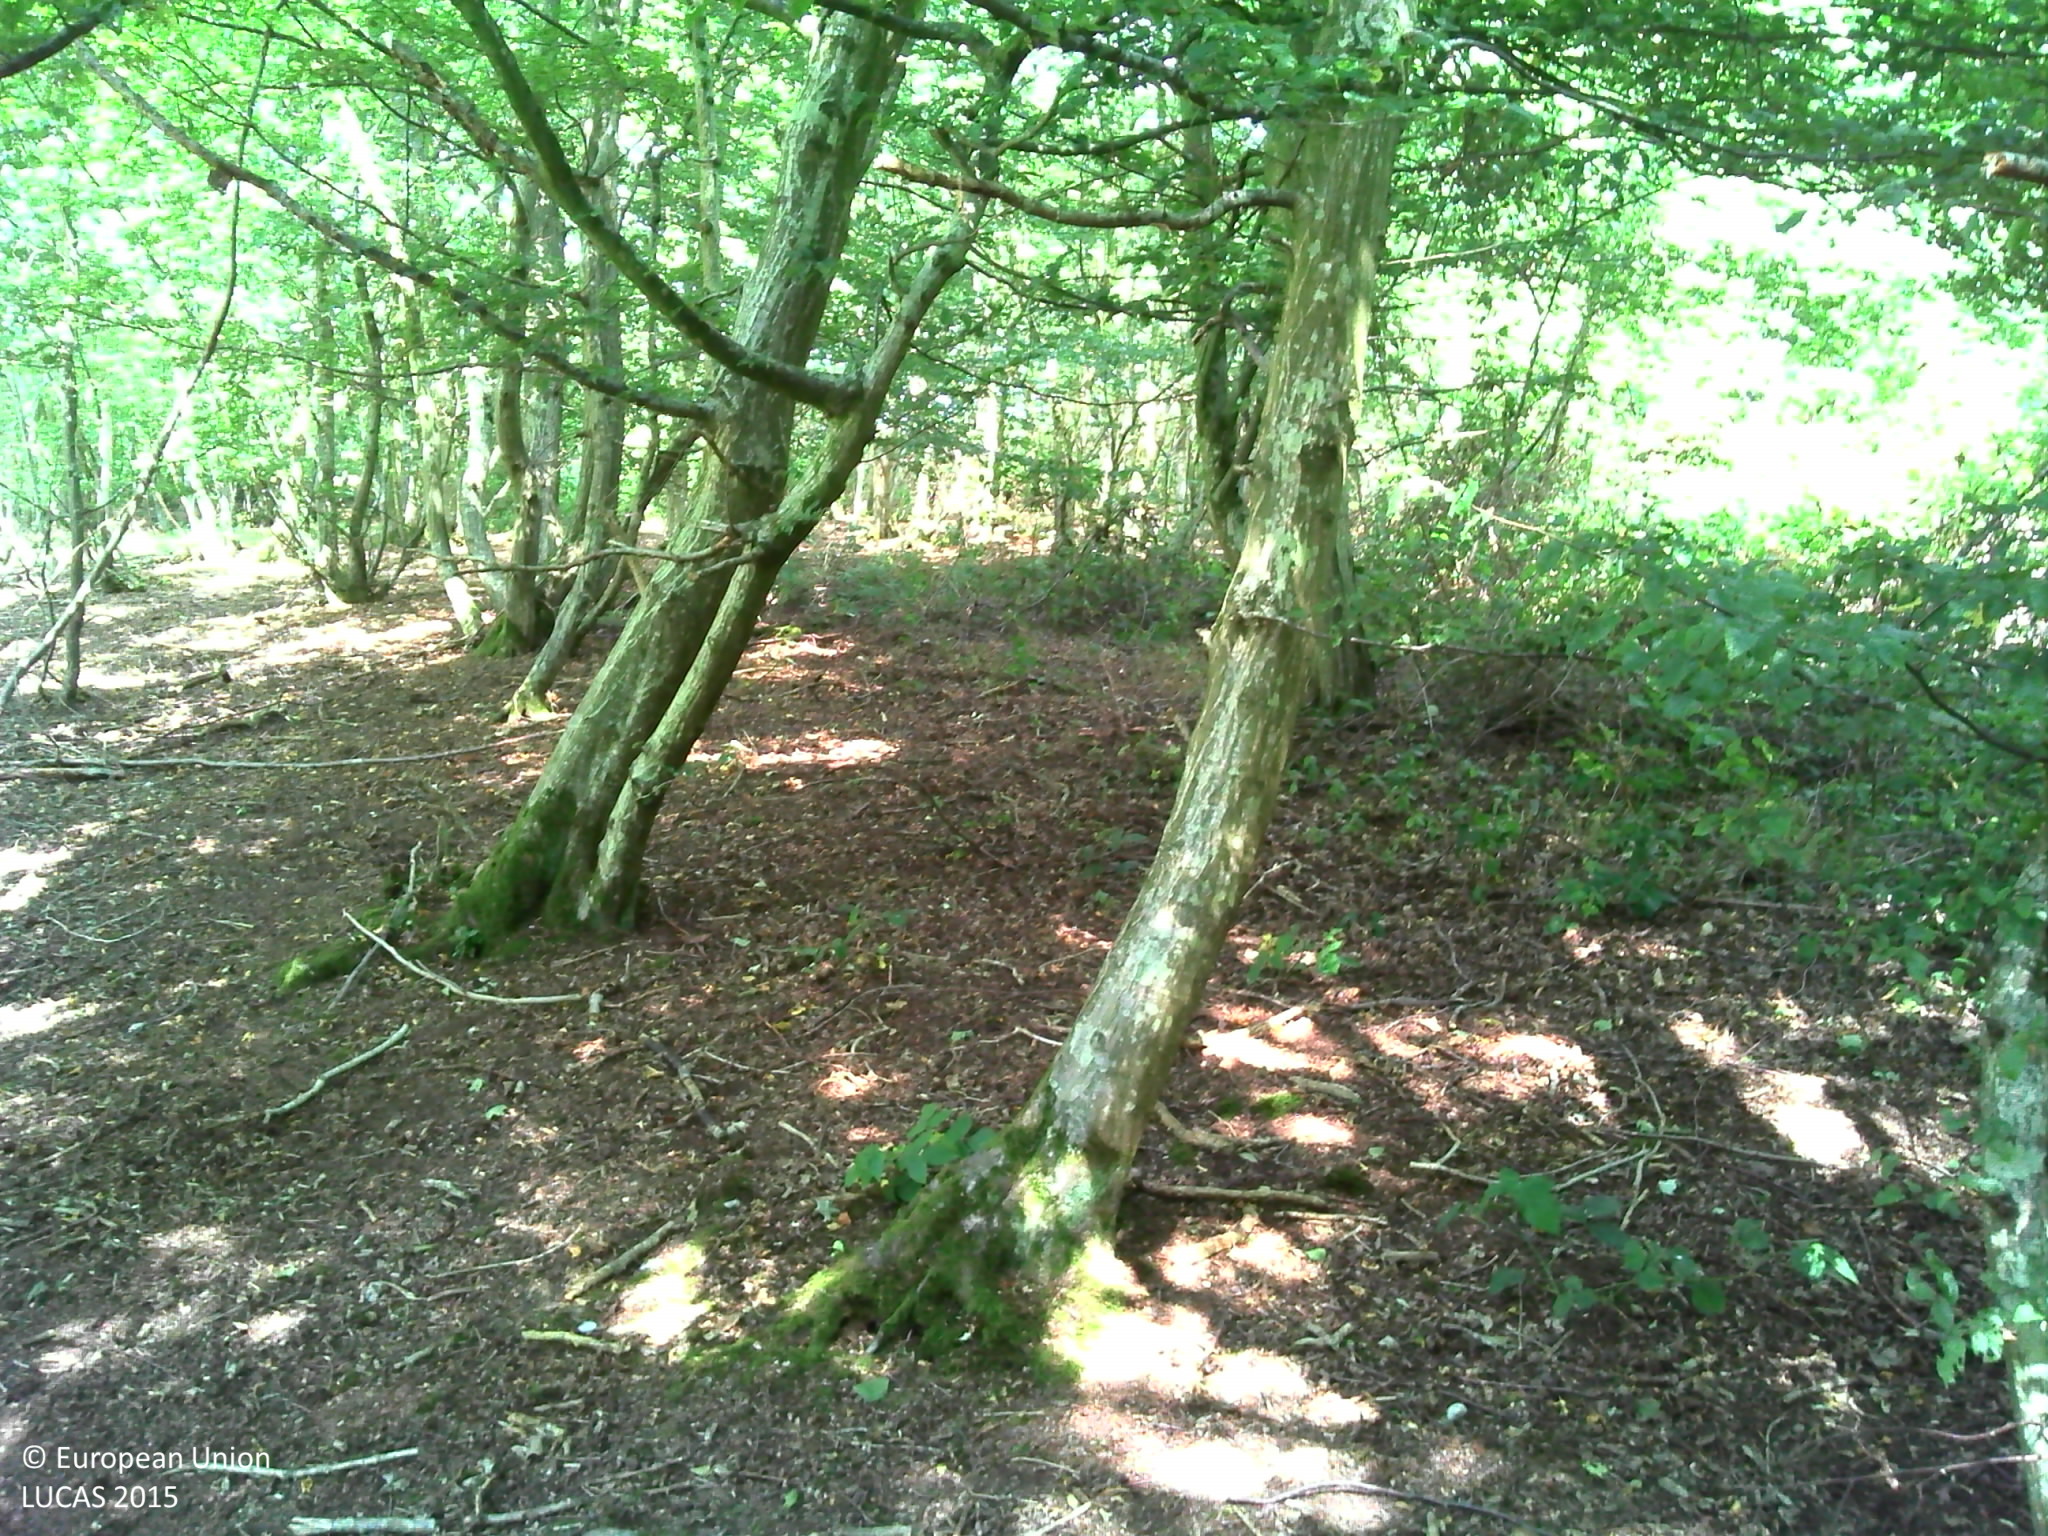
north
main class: Woodland
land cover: Broadleaved woodland
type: mesophytic deciduous forest
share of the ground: > 75 %
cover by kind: broadleaved forest trees 90 %, lichens and mosses 5 %, unconsolidated bare surface 5 %
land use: Forestry
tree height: > 5 m
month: August
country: FR
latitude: 50.8615
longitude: 2.0139
